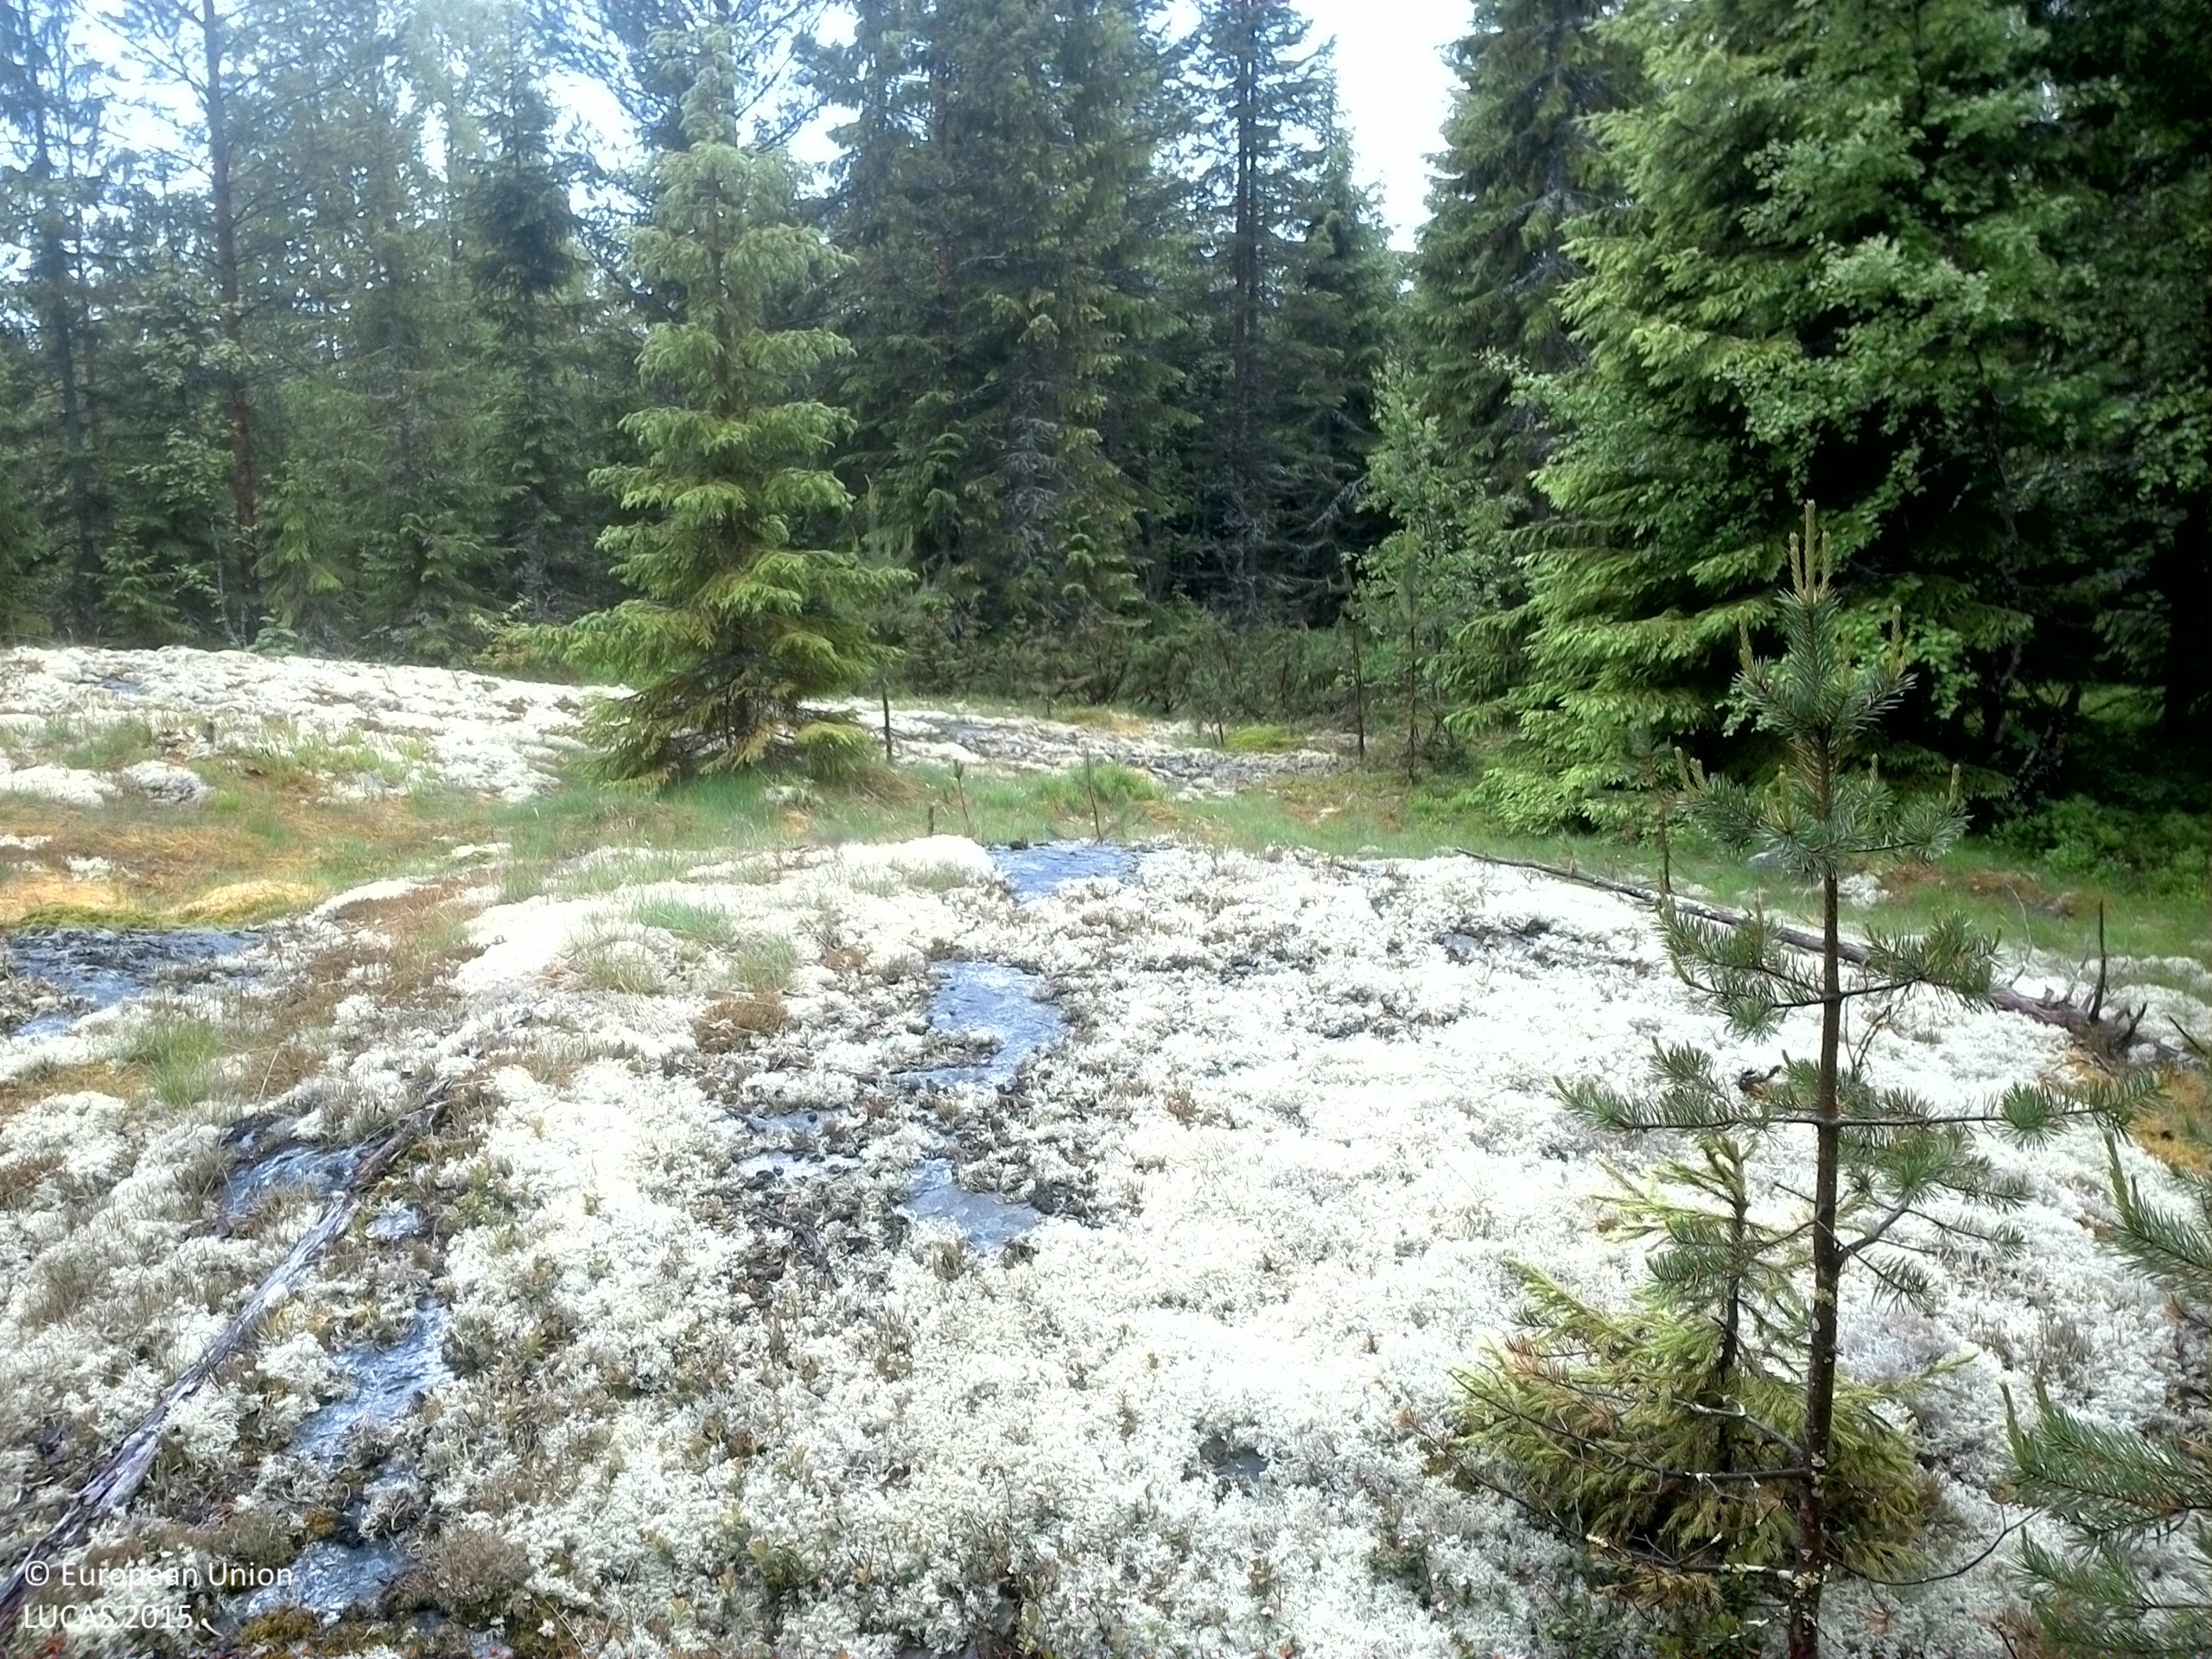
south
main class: Woodland
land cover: Spruce dominated mixed woodland
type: boreal forest
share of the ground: > 75 %
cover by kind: coniferous forest trees 50 %, broadleaved forest trees 30 %, shrubs 20 %
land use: Forestry
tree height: > 5 m
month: June
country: SE
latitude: 62.7469
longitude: 17.9464
